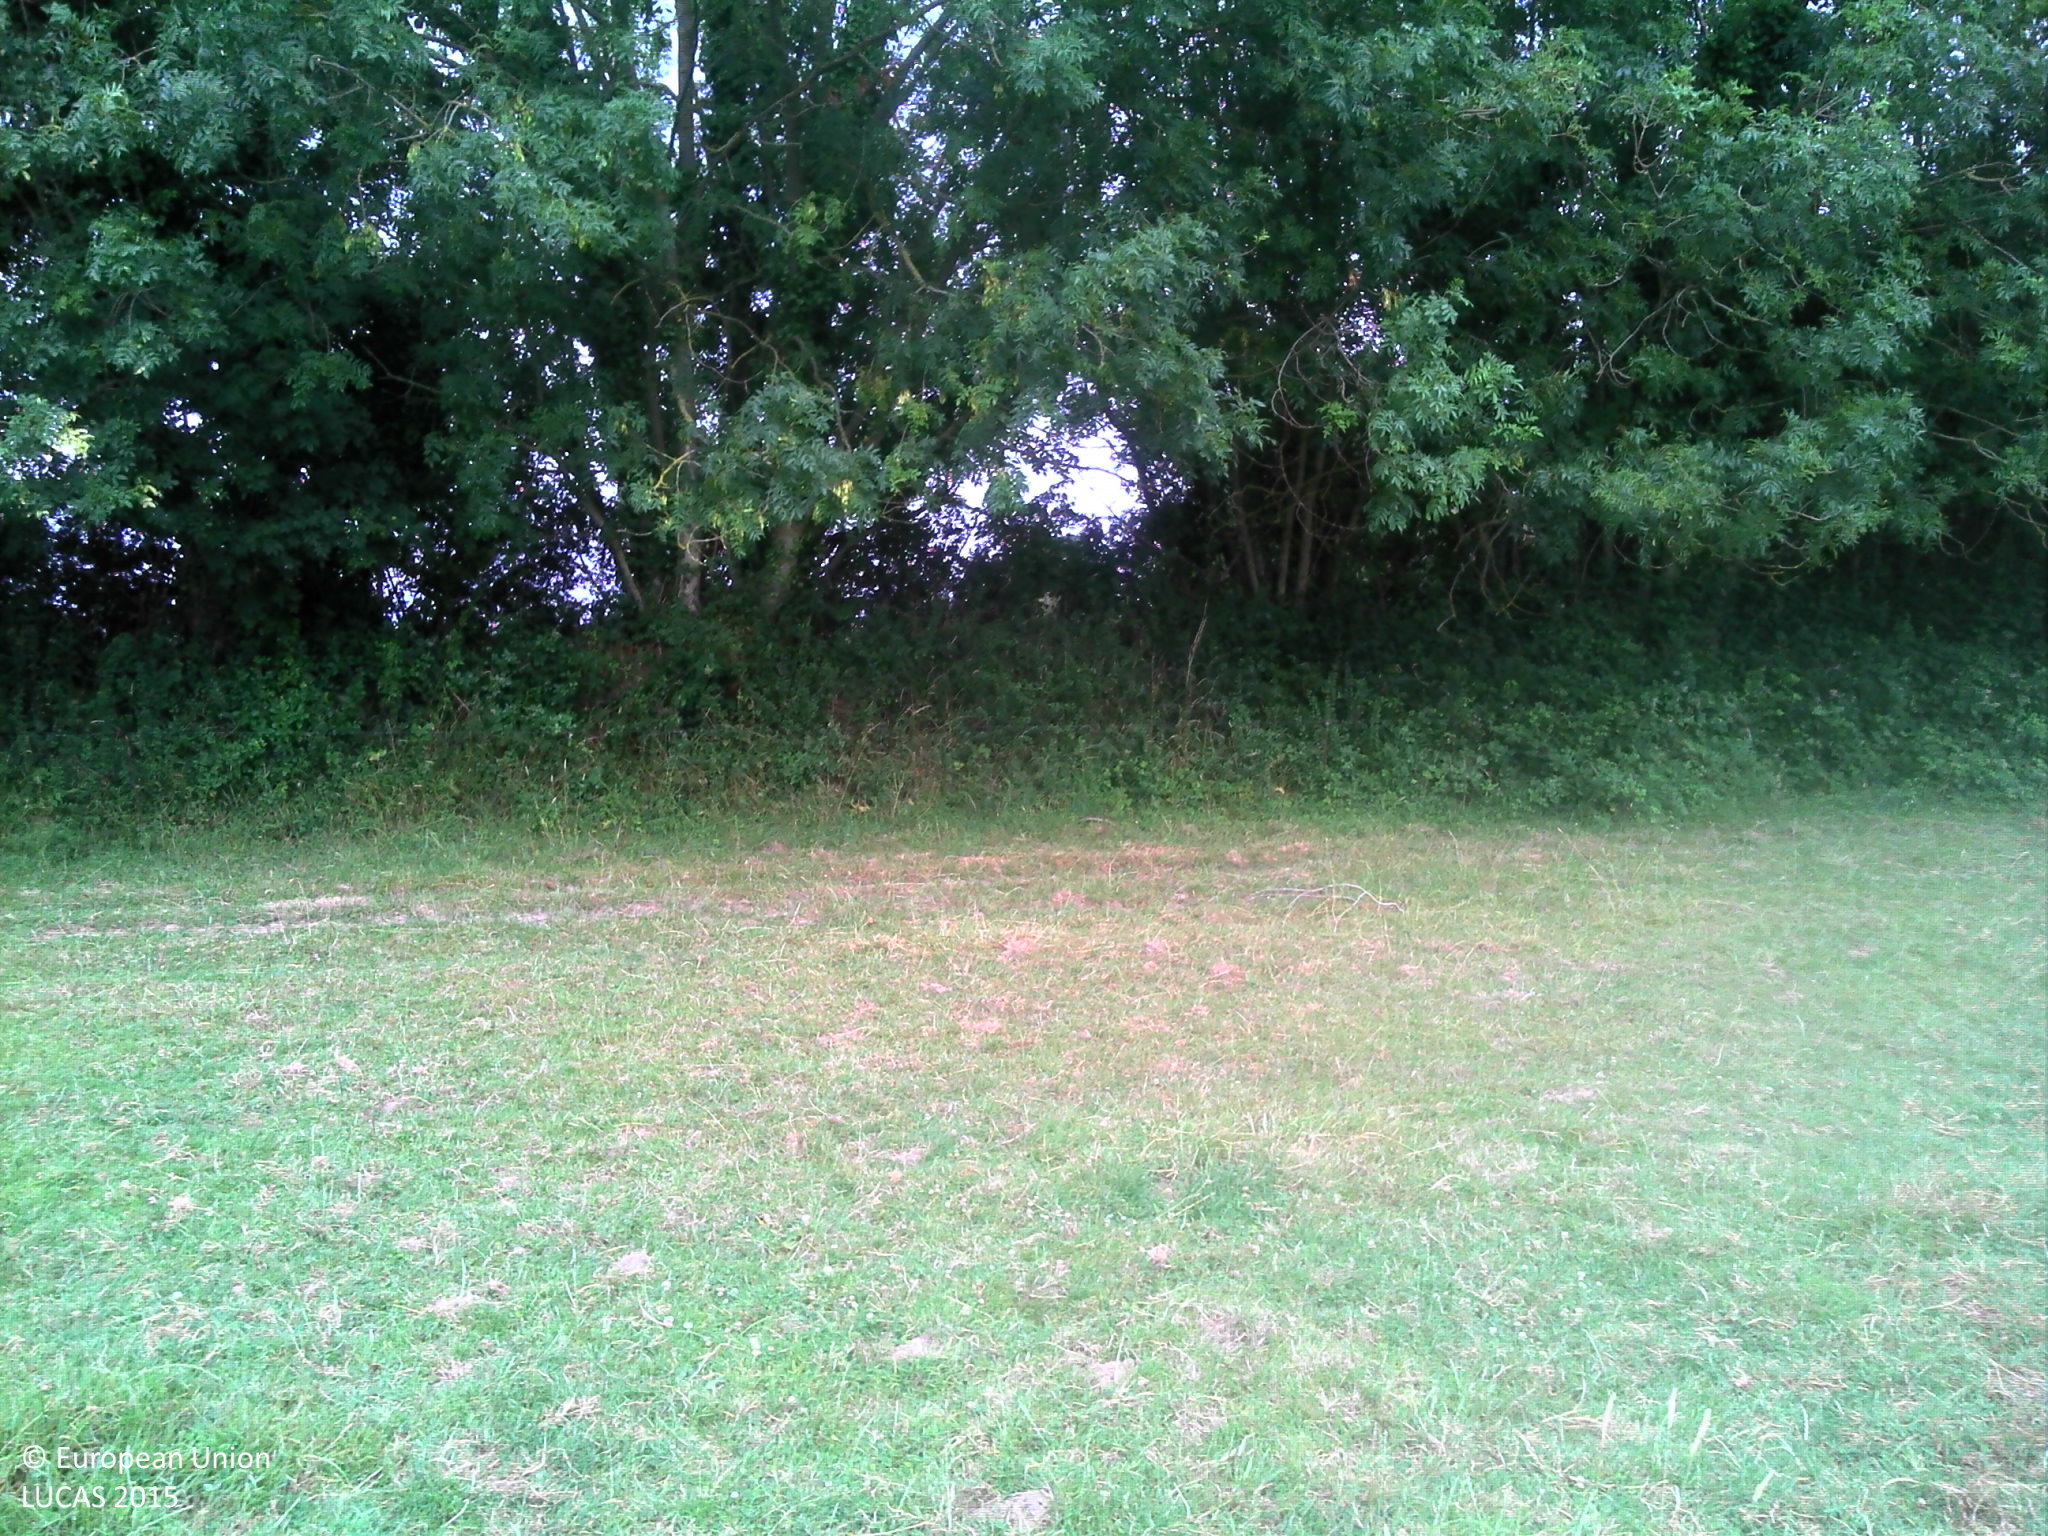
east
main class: Grassland
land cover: Grassland without tree/shrub cover
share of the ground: > 75 %
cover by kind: herbaceous plants 100 %
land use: Agriculture (excluding fallow land and kitchen gardens)
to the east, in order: Grassland without tree/shrub cover; Fences; Broadleaved woodland; Temporary grasslands; Electric lines; Temporary grasslands; Abandoned hedges; Grassland without tree/shrub cover
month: July
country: FR
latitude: 48.8308
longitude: -1.5600
